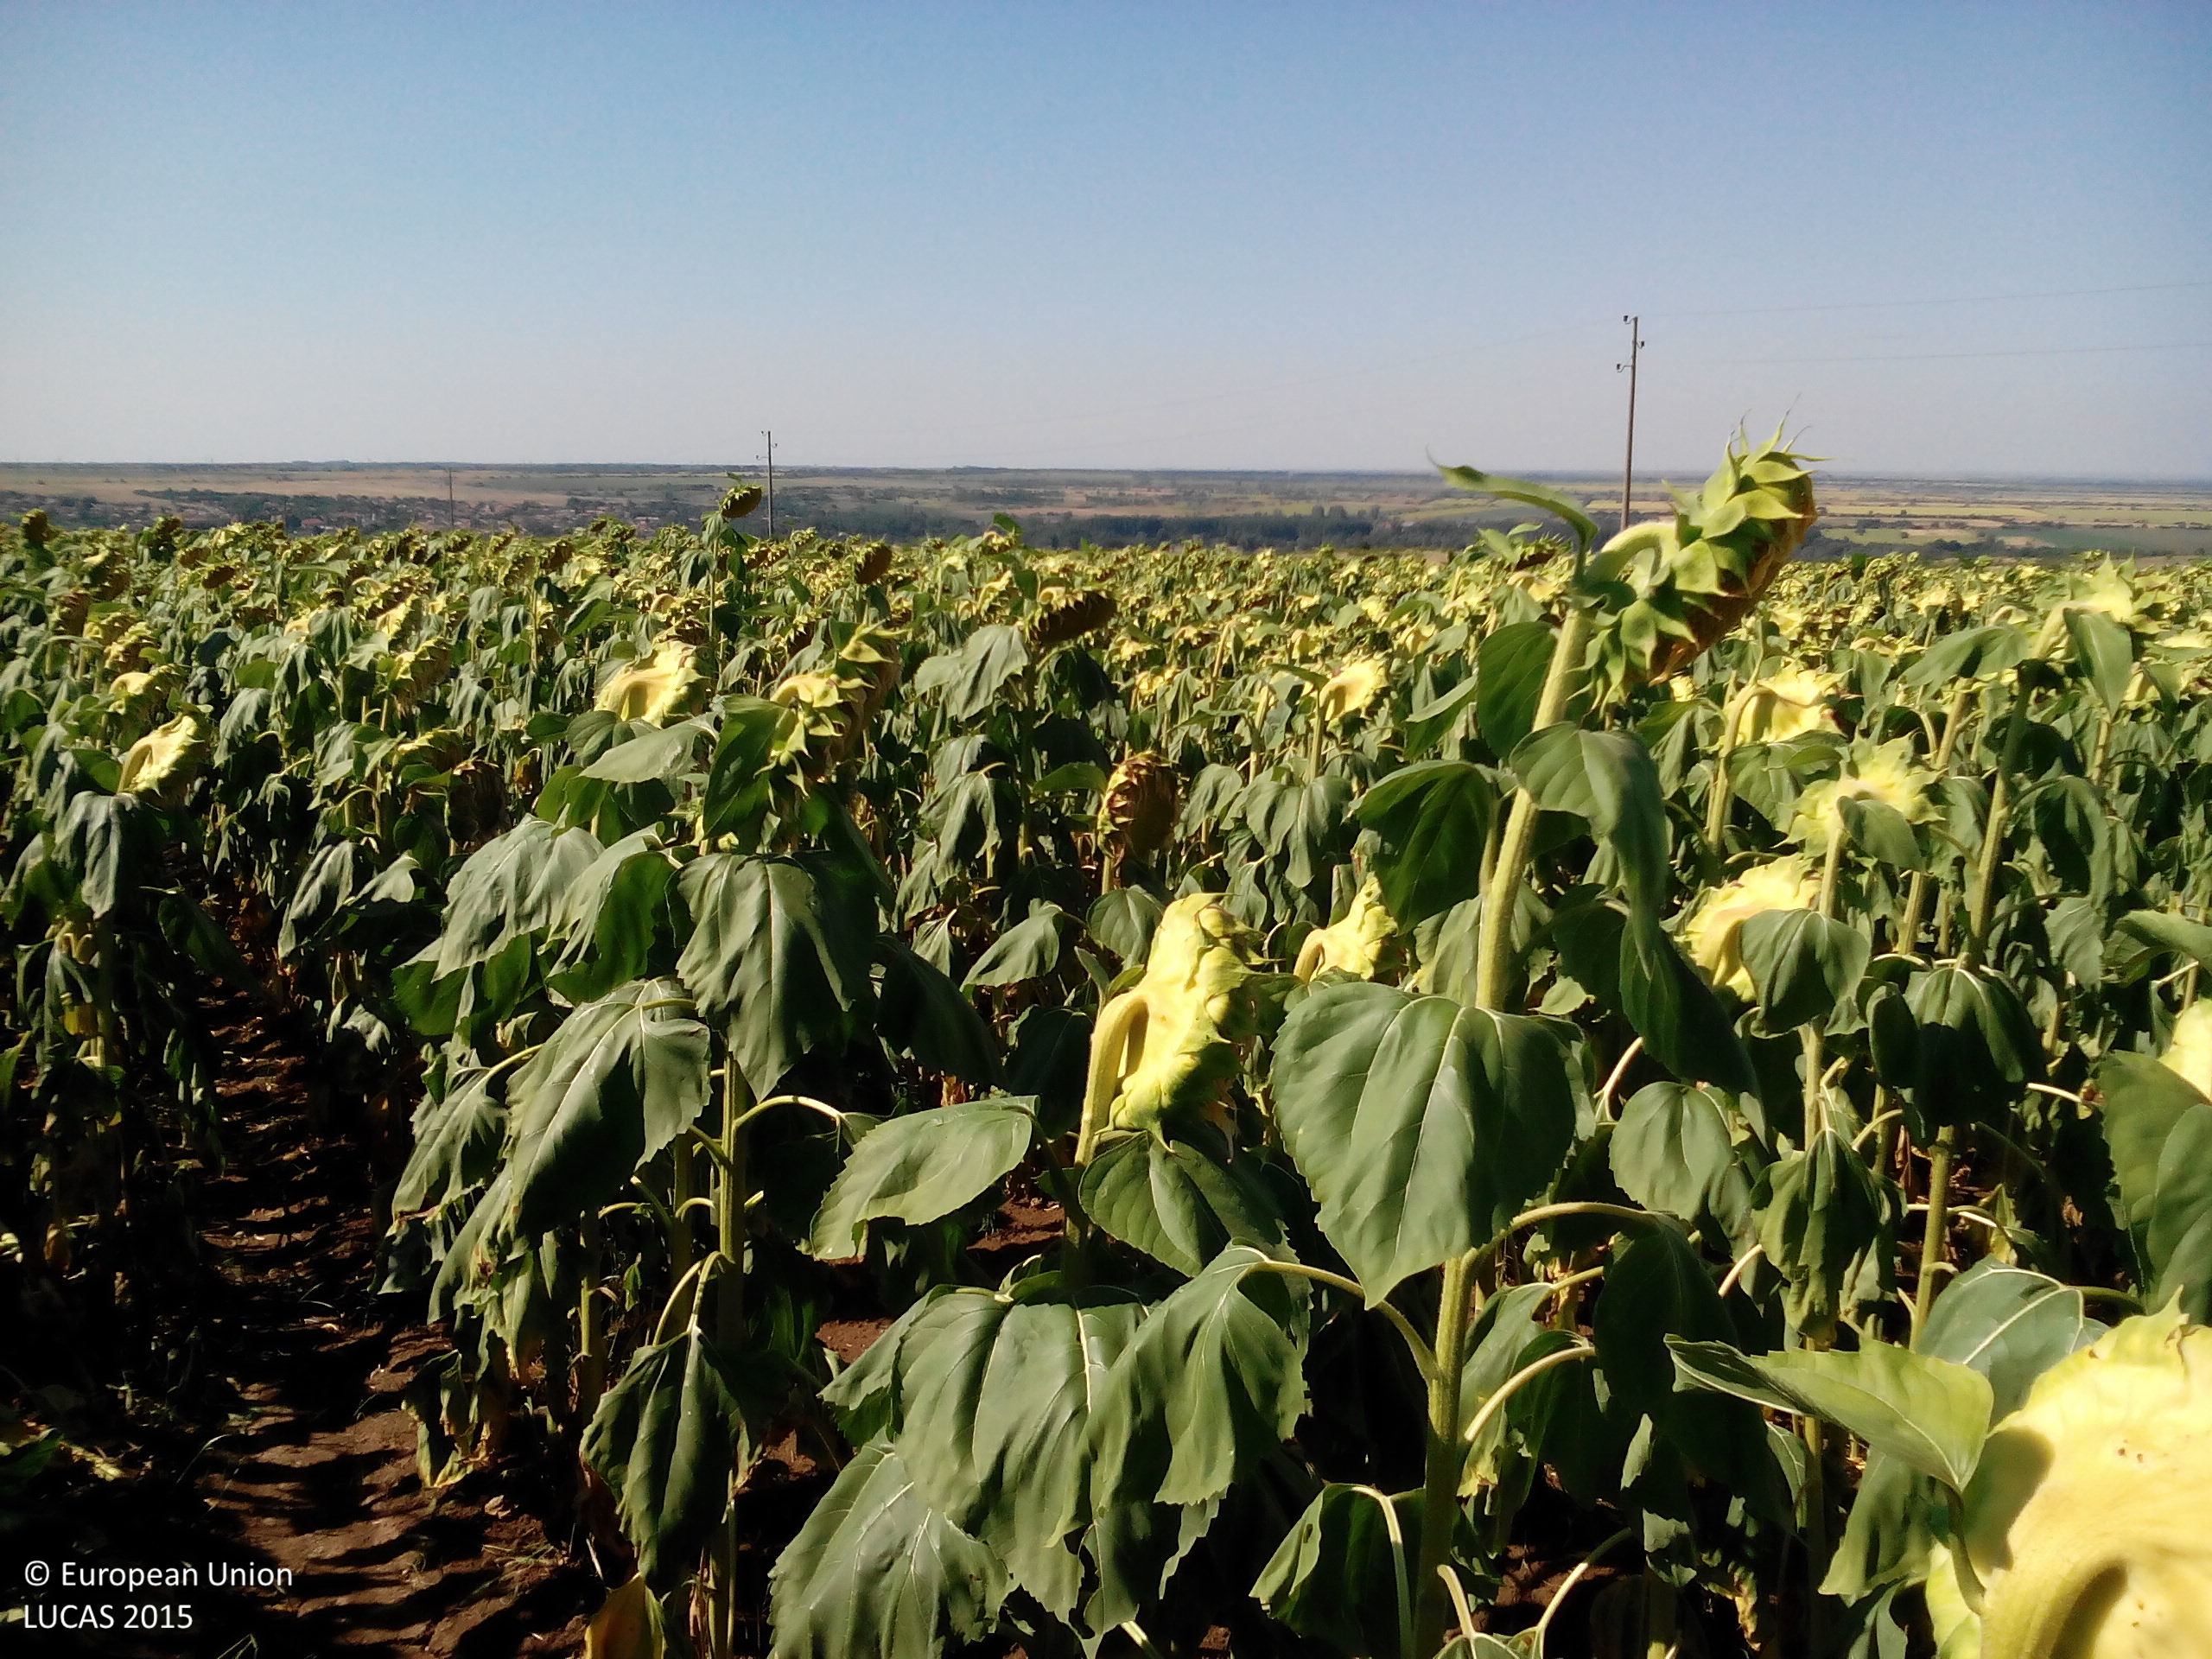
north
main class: Cropland
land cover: Sunflower
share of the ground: > 75 %
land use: Agriculture (excluding fallow land and kitchen gardens)
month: July
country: BG
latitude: 43.2899
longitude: 24.3662
